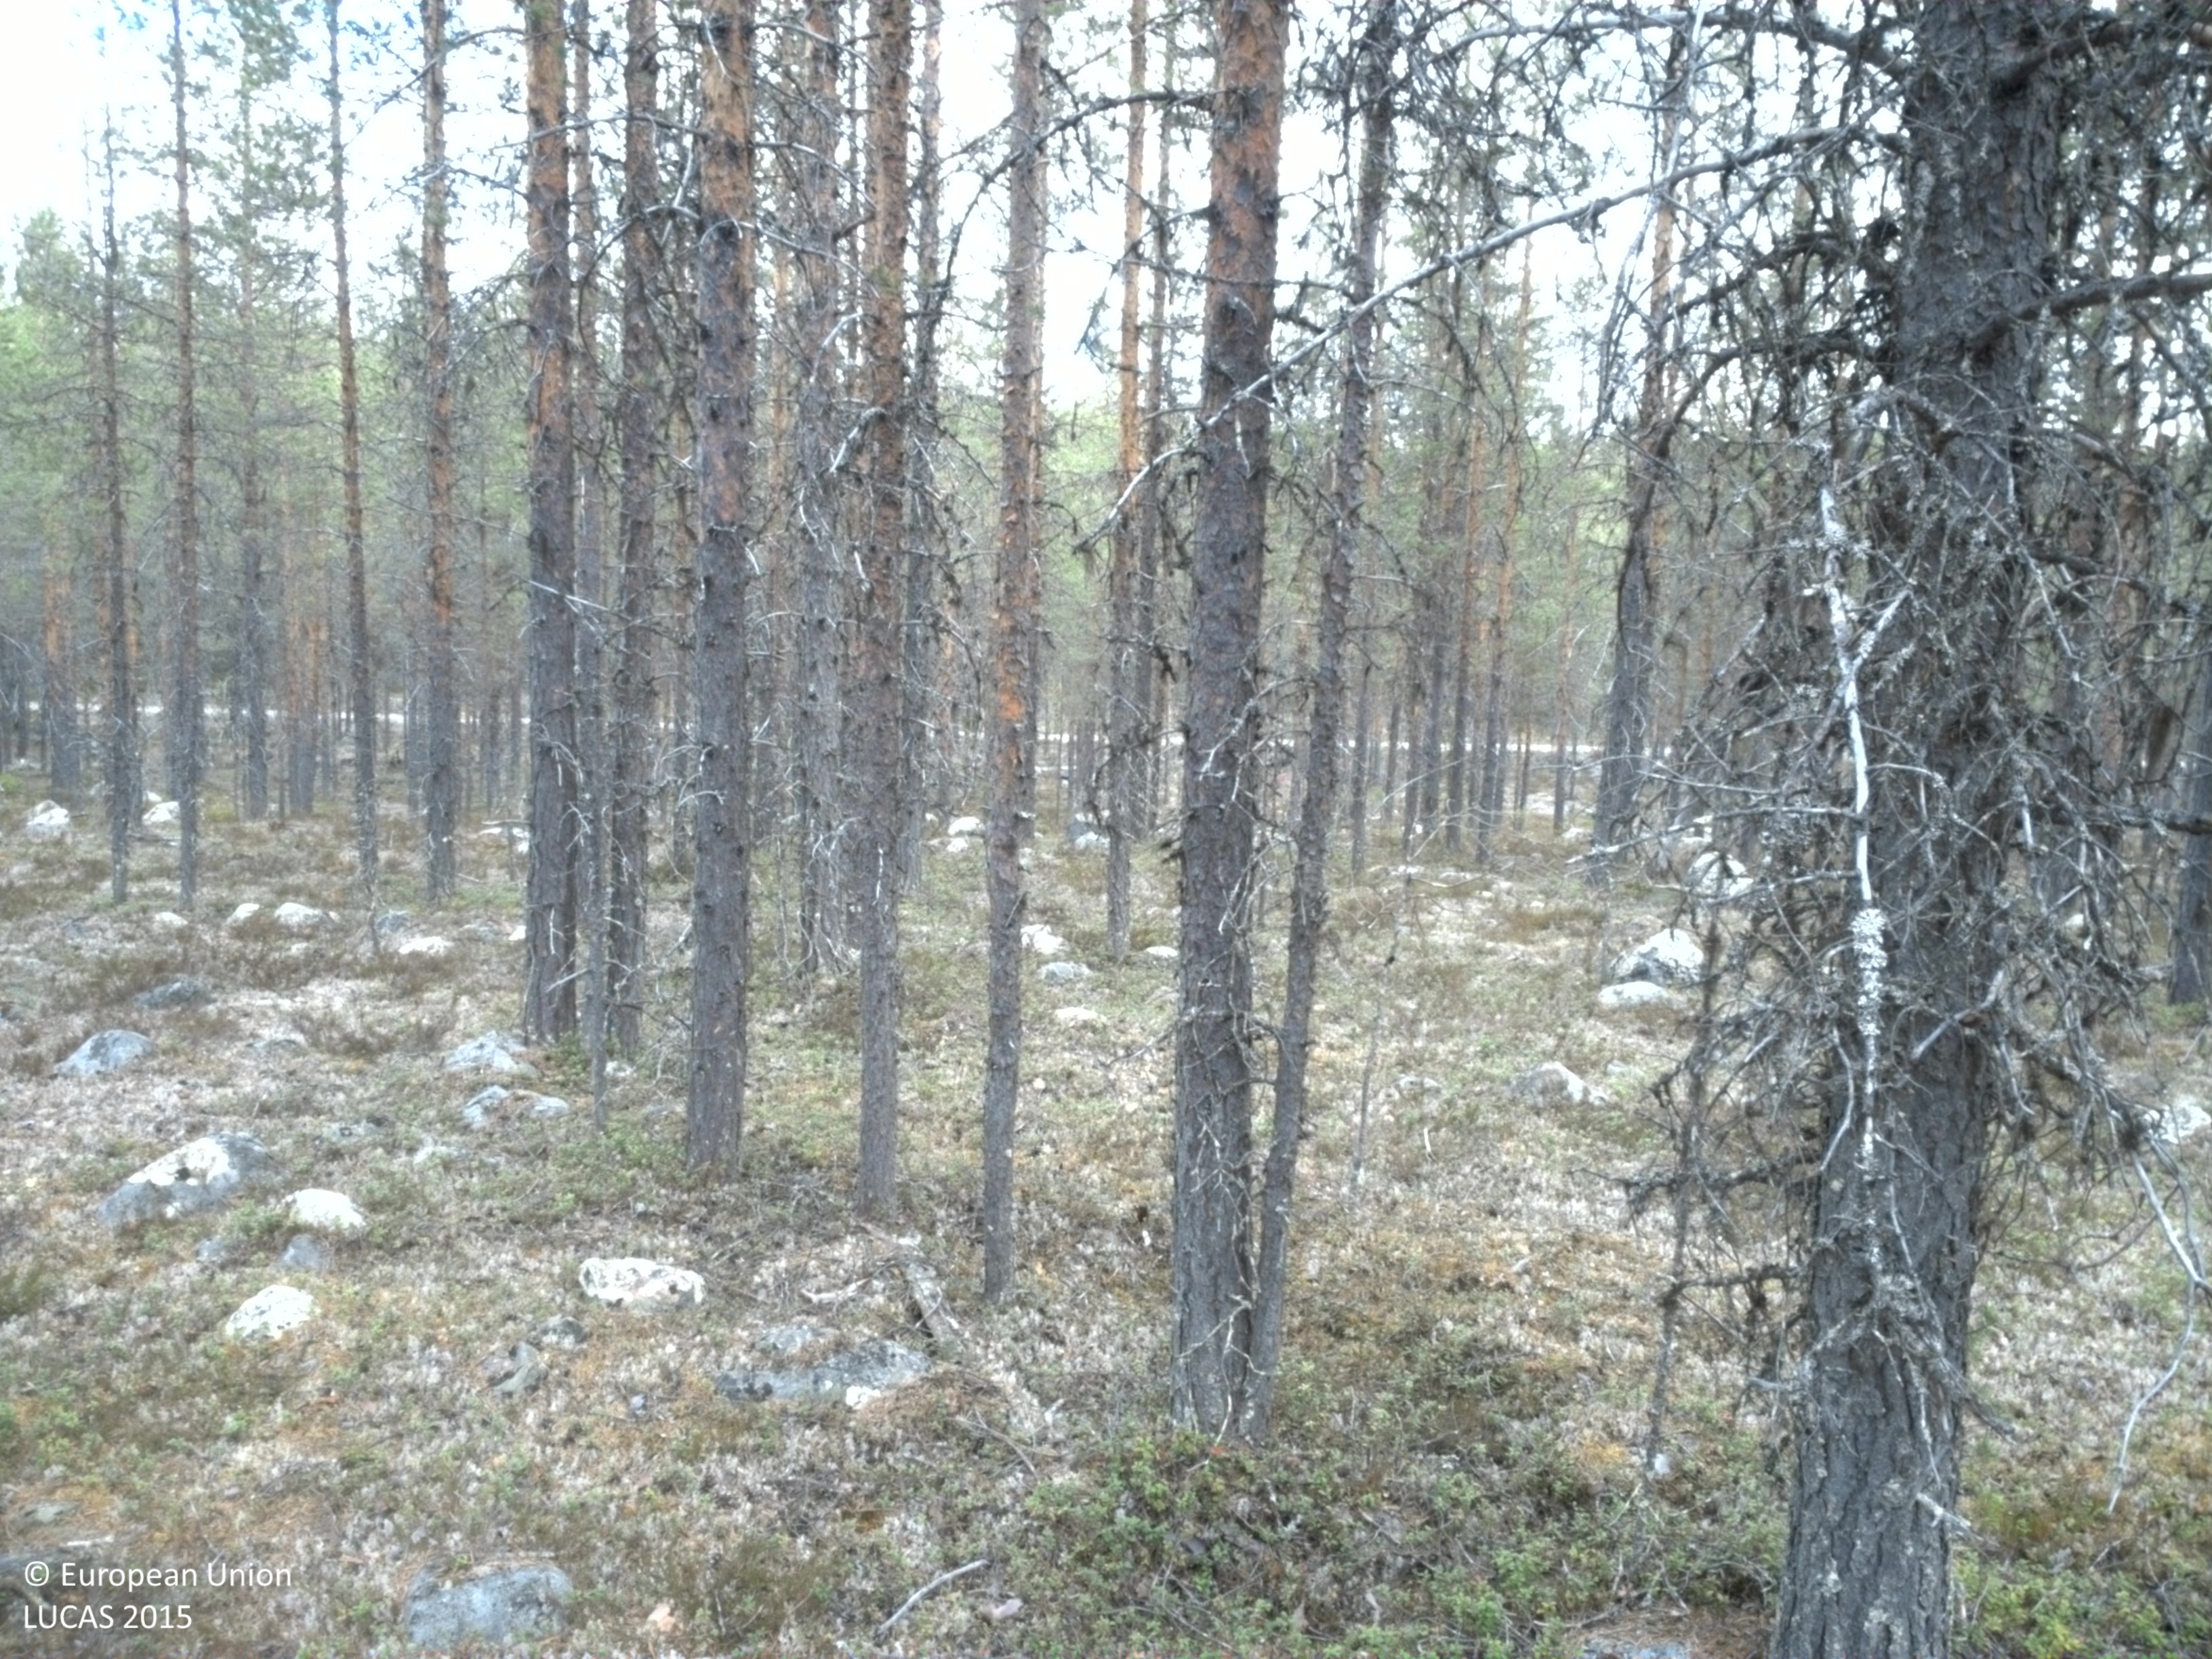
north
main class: Woodland
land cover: Pine dominated coniferous woodland
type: boreal forest
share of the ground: 25 - 50 %
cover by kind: shrubs 40 %, coniferous forest trees 35 %, lichens and mosses 20 %, consolidated bare surface 5 %
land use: Forestry
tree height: > 5 m
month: June
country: SE
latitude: 65.9196
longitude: 19.7772
